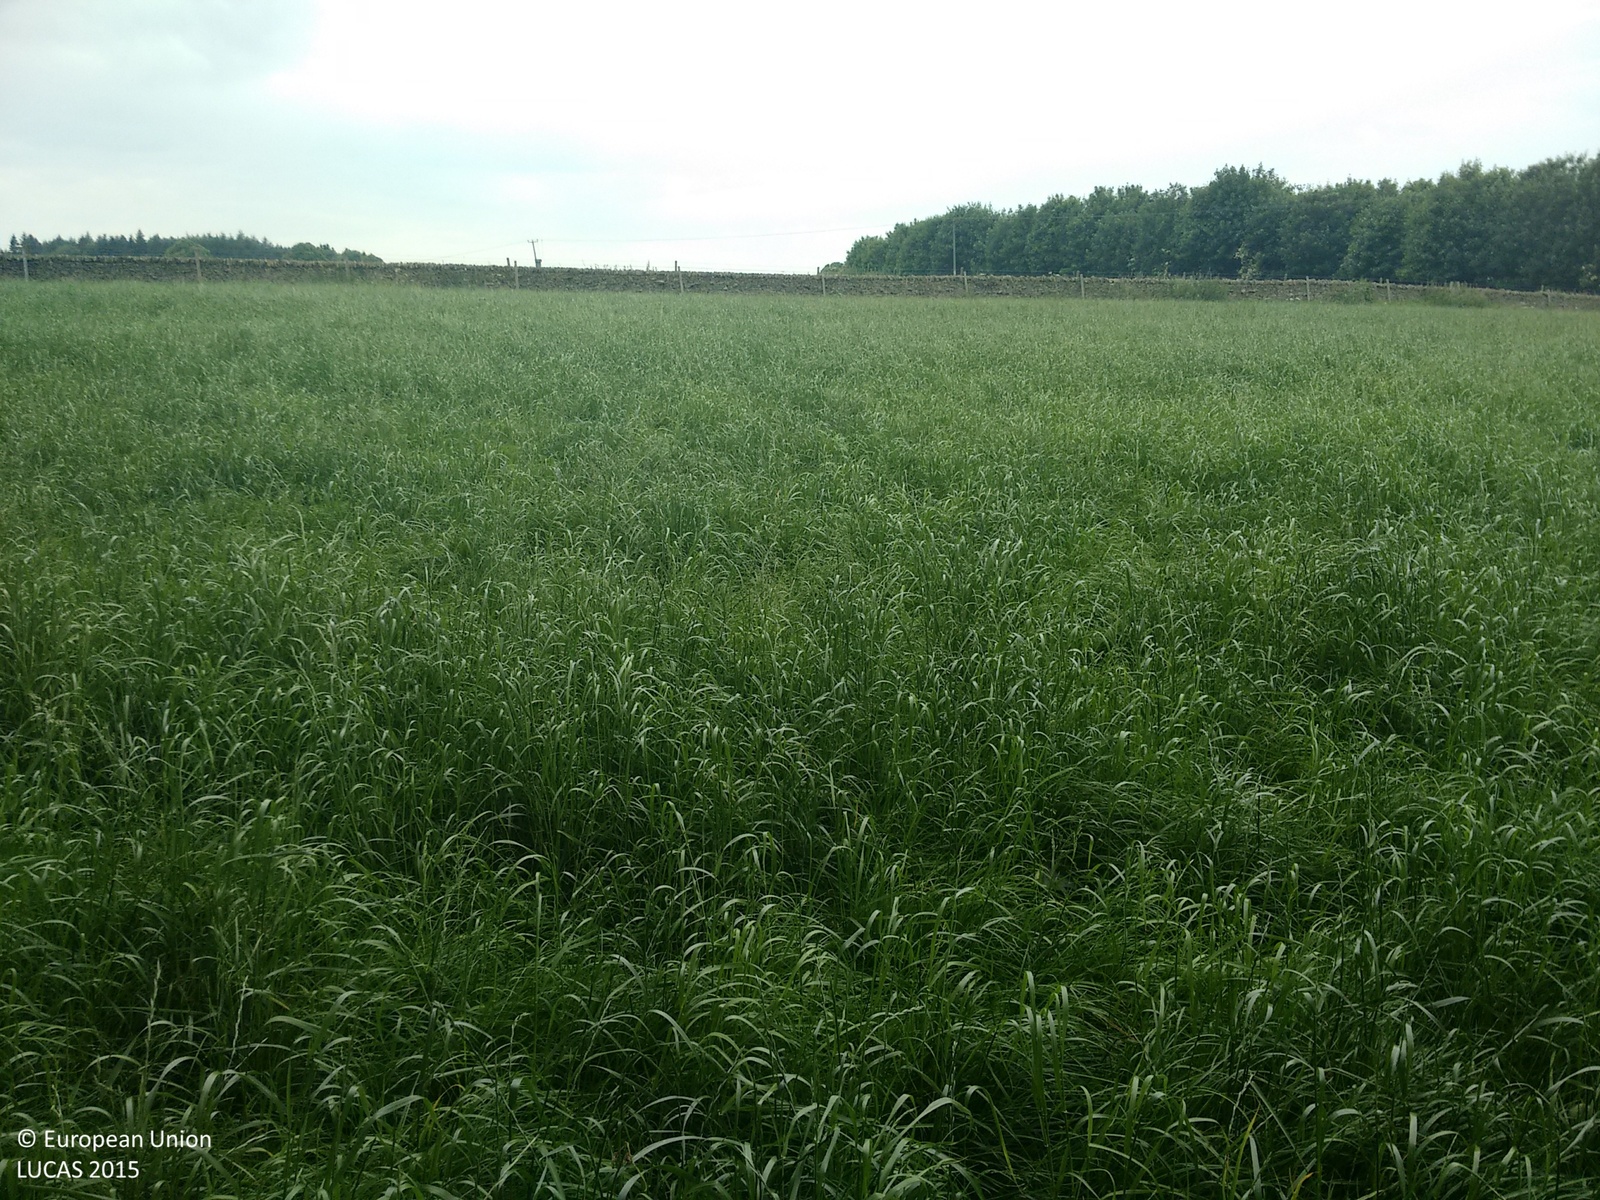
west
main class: Grassland
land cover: Grassland without tree/shrub cover
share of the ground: > 75 %
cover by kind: herbaceous plants 100 %
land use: Agriculture (excluding fallow land and kitchen gardens)
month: July
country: GB
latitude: 53.2387
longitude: -1.6345
